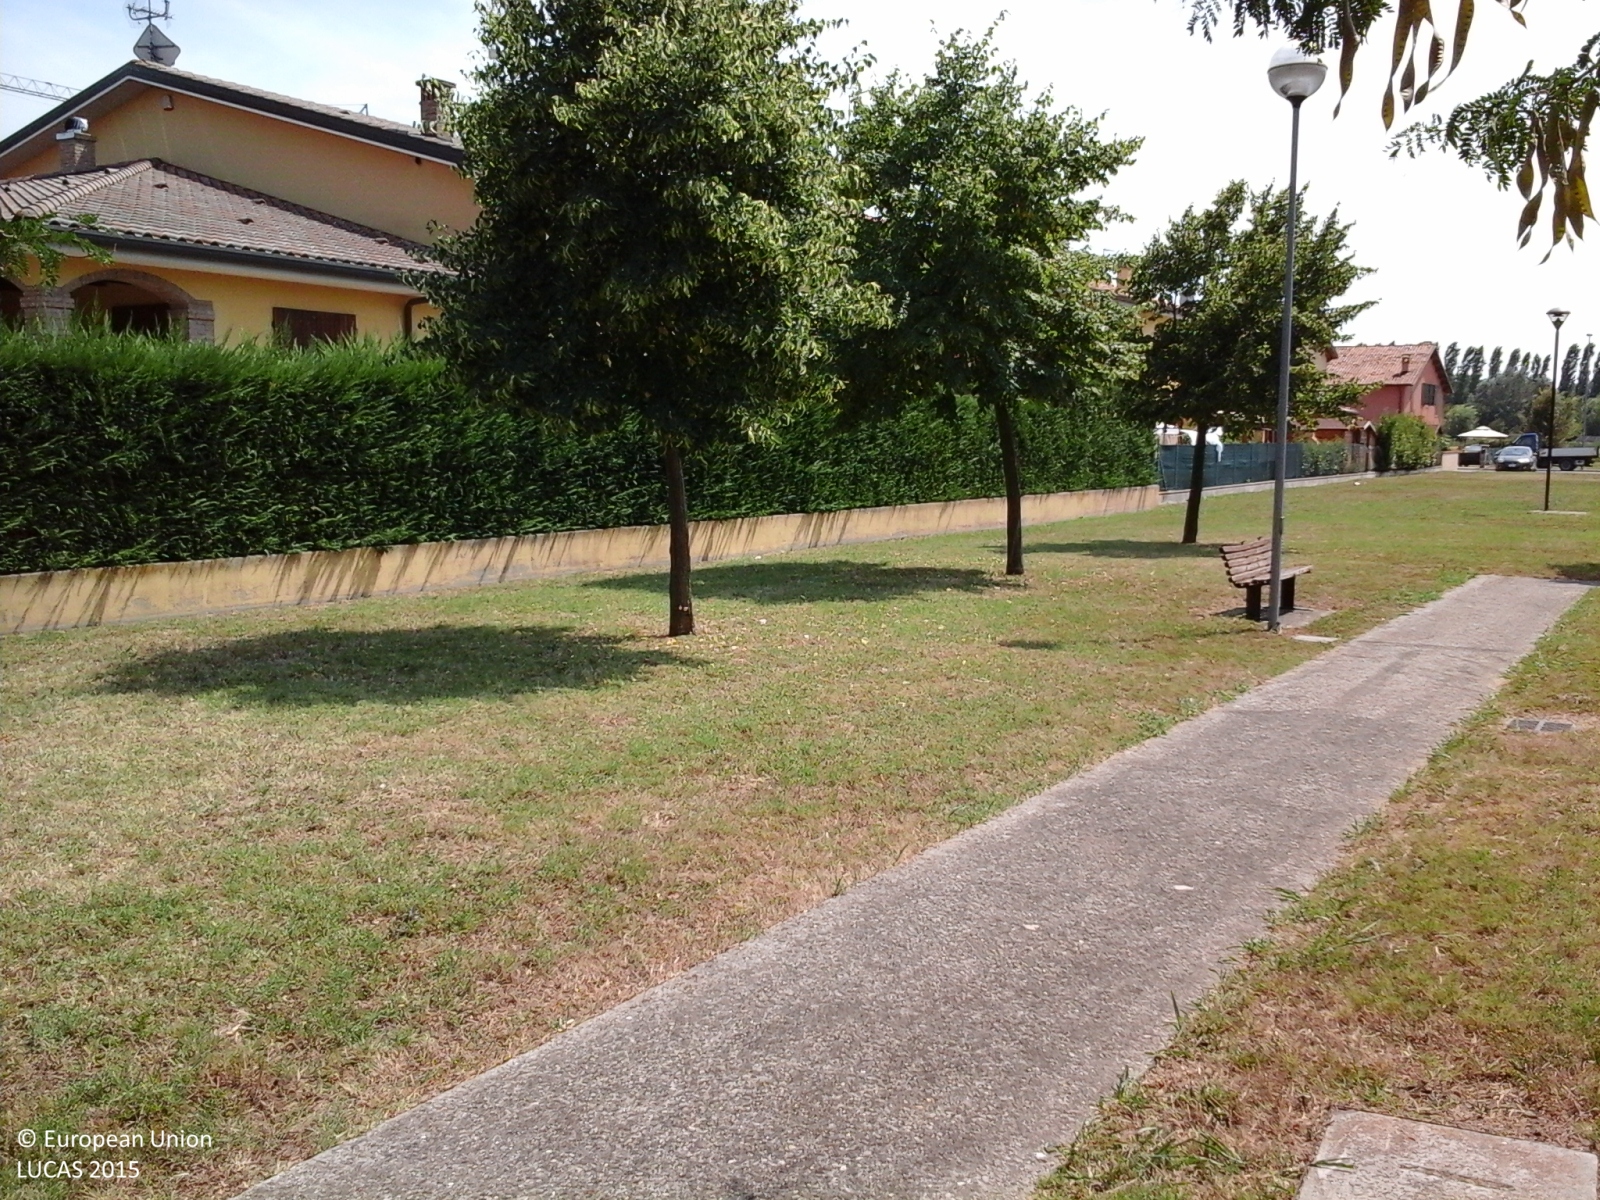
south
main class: Grassland
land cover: Grassland with sparse tree/shrub cover
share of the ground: > 75 %
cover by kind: herbaceous plants 95 %, broadleaved forest trees 5 %
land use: Residential
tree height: > 5 m
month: July
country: IT
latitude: 44.6621
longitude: 11.6488
